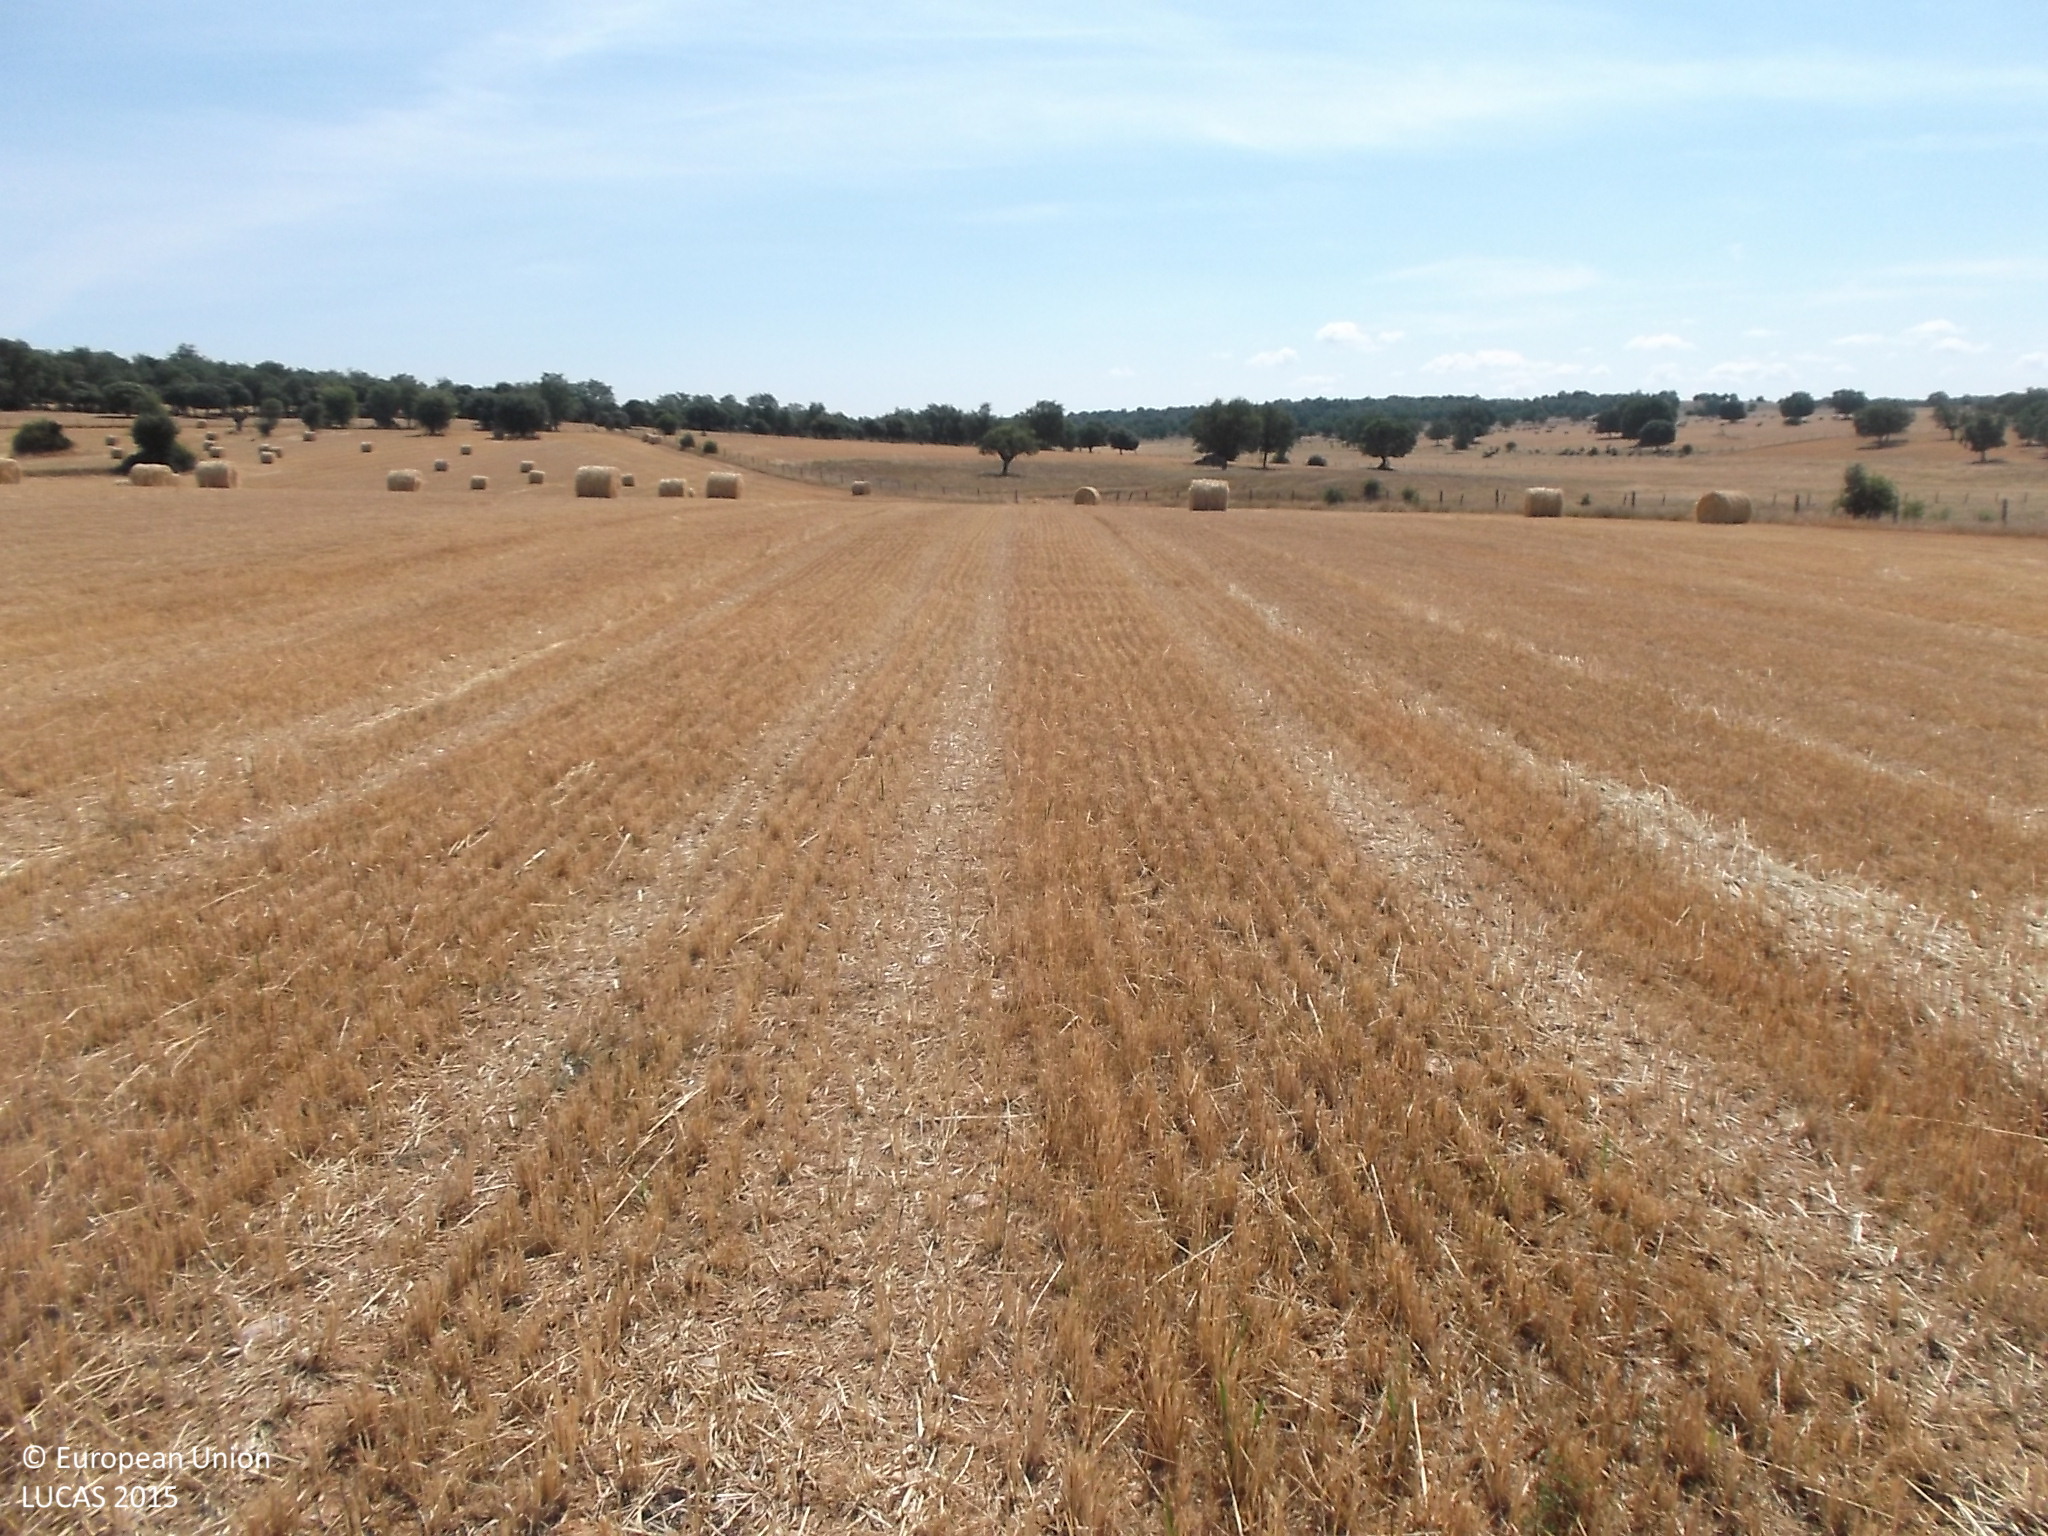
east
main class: Cropland
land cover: Mixed cereals for fodder
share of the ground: < 10 %
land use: Agriculture (excluding fallow land and kitchen gardens)
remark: Harvested field
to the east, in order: Mixed cereals for fodder; Grass margins; Fences; Tracks; Grassland without tree/shrub cover; Tracks; Grassland without tree/shrub cover
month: June
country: ES
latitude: 41.2095
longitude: -5.9850
